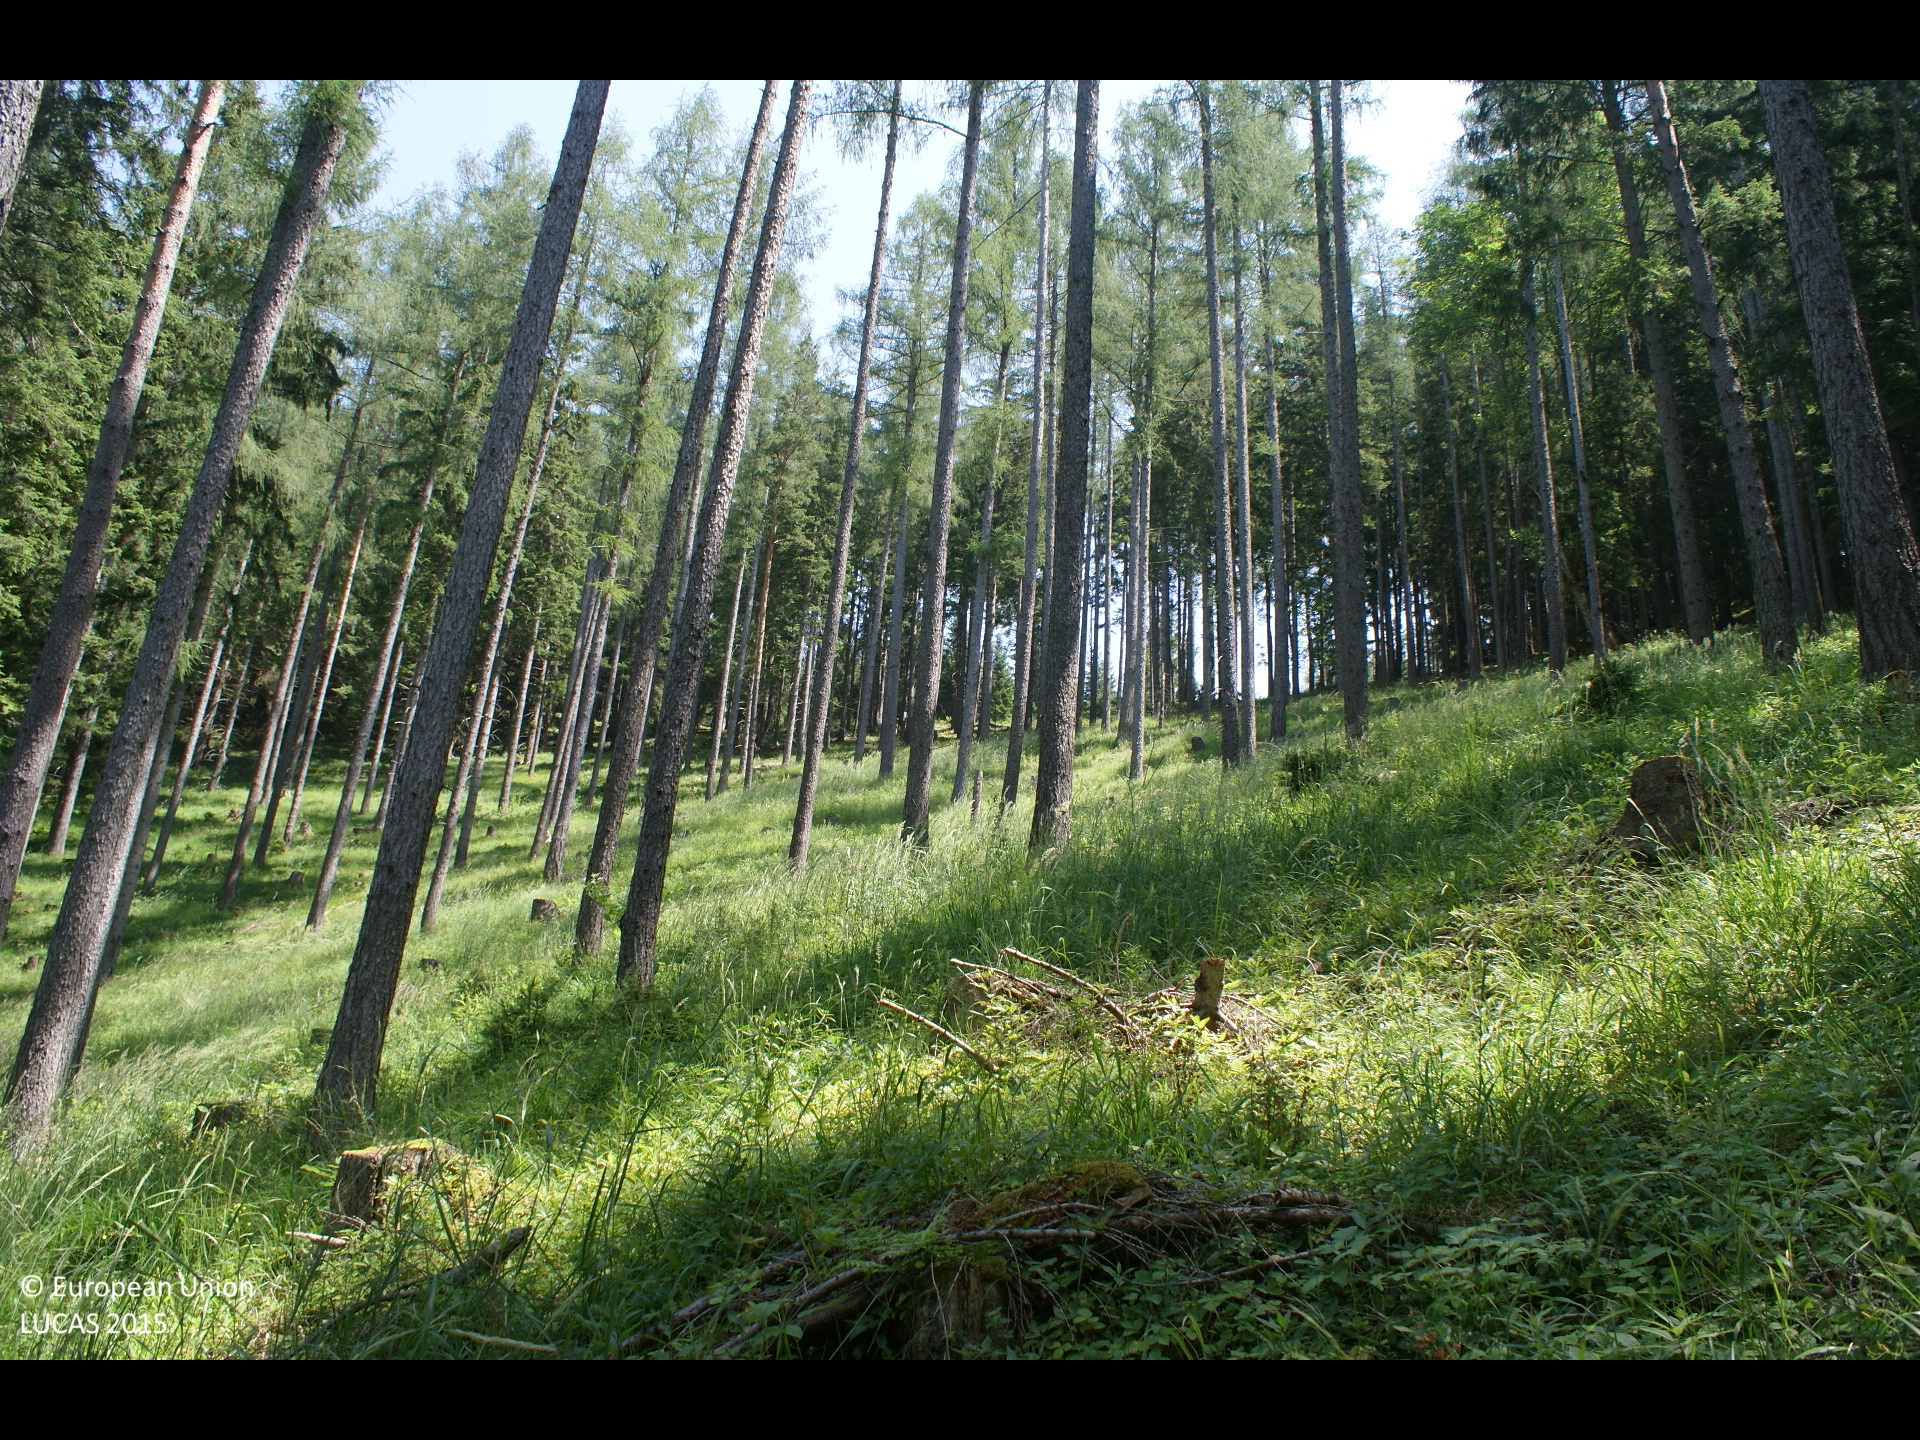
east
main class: Woodland
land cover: Other coniferous woodland
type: alpine coniferous forest
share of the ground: > 75 %
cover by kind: coniferous forest trees 75 %, herbaceous plants 20 %, shrubs 5 %
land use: Forestry
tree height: > 5 m
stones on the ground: < 10 %
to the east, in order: Other coniferous woodland; Spruce dominated coniferous woodland; Other coniferous woodland; Tracks; Spruce dominated coniferous woodland
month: July
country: AT
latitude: 47.8433
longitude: 15.3060
